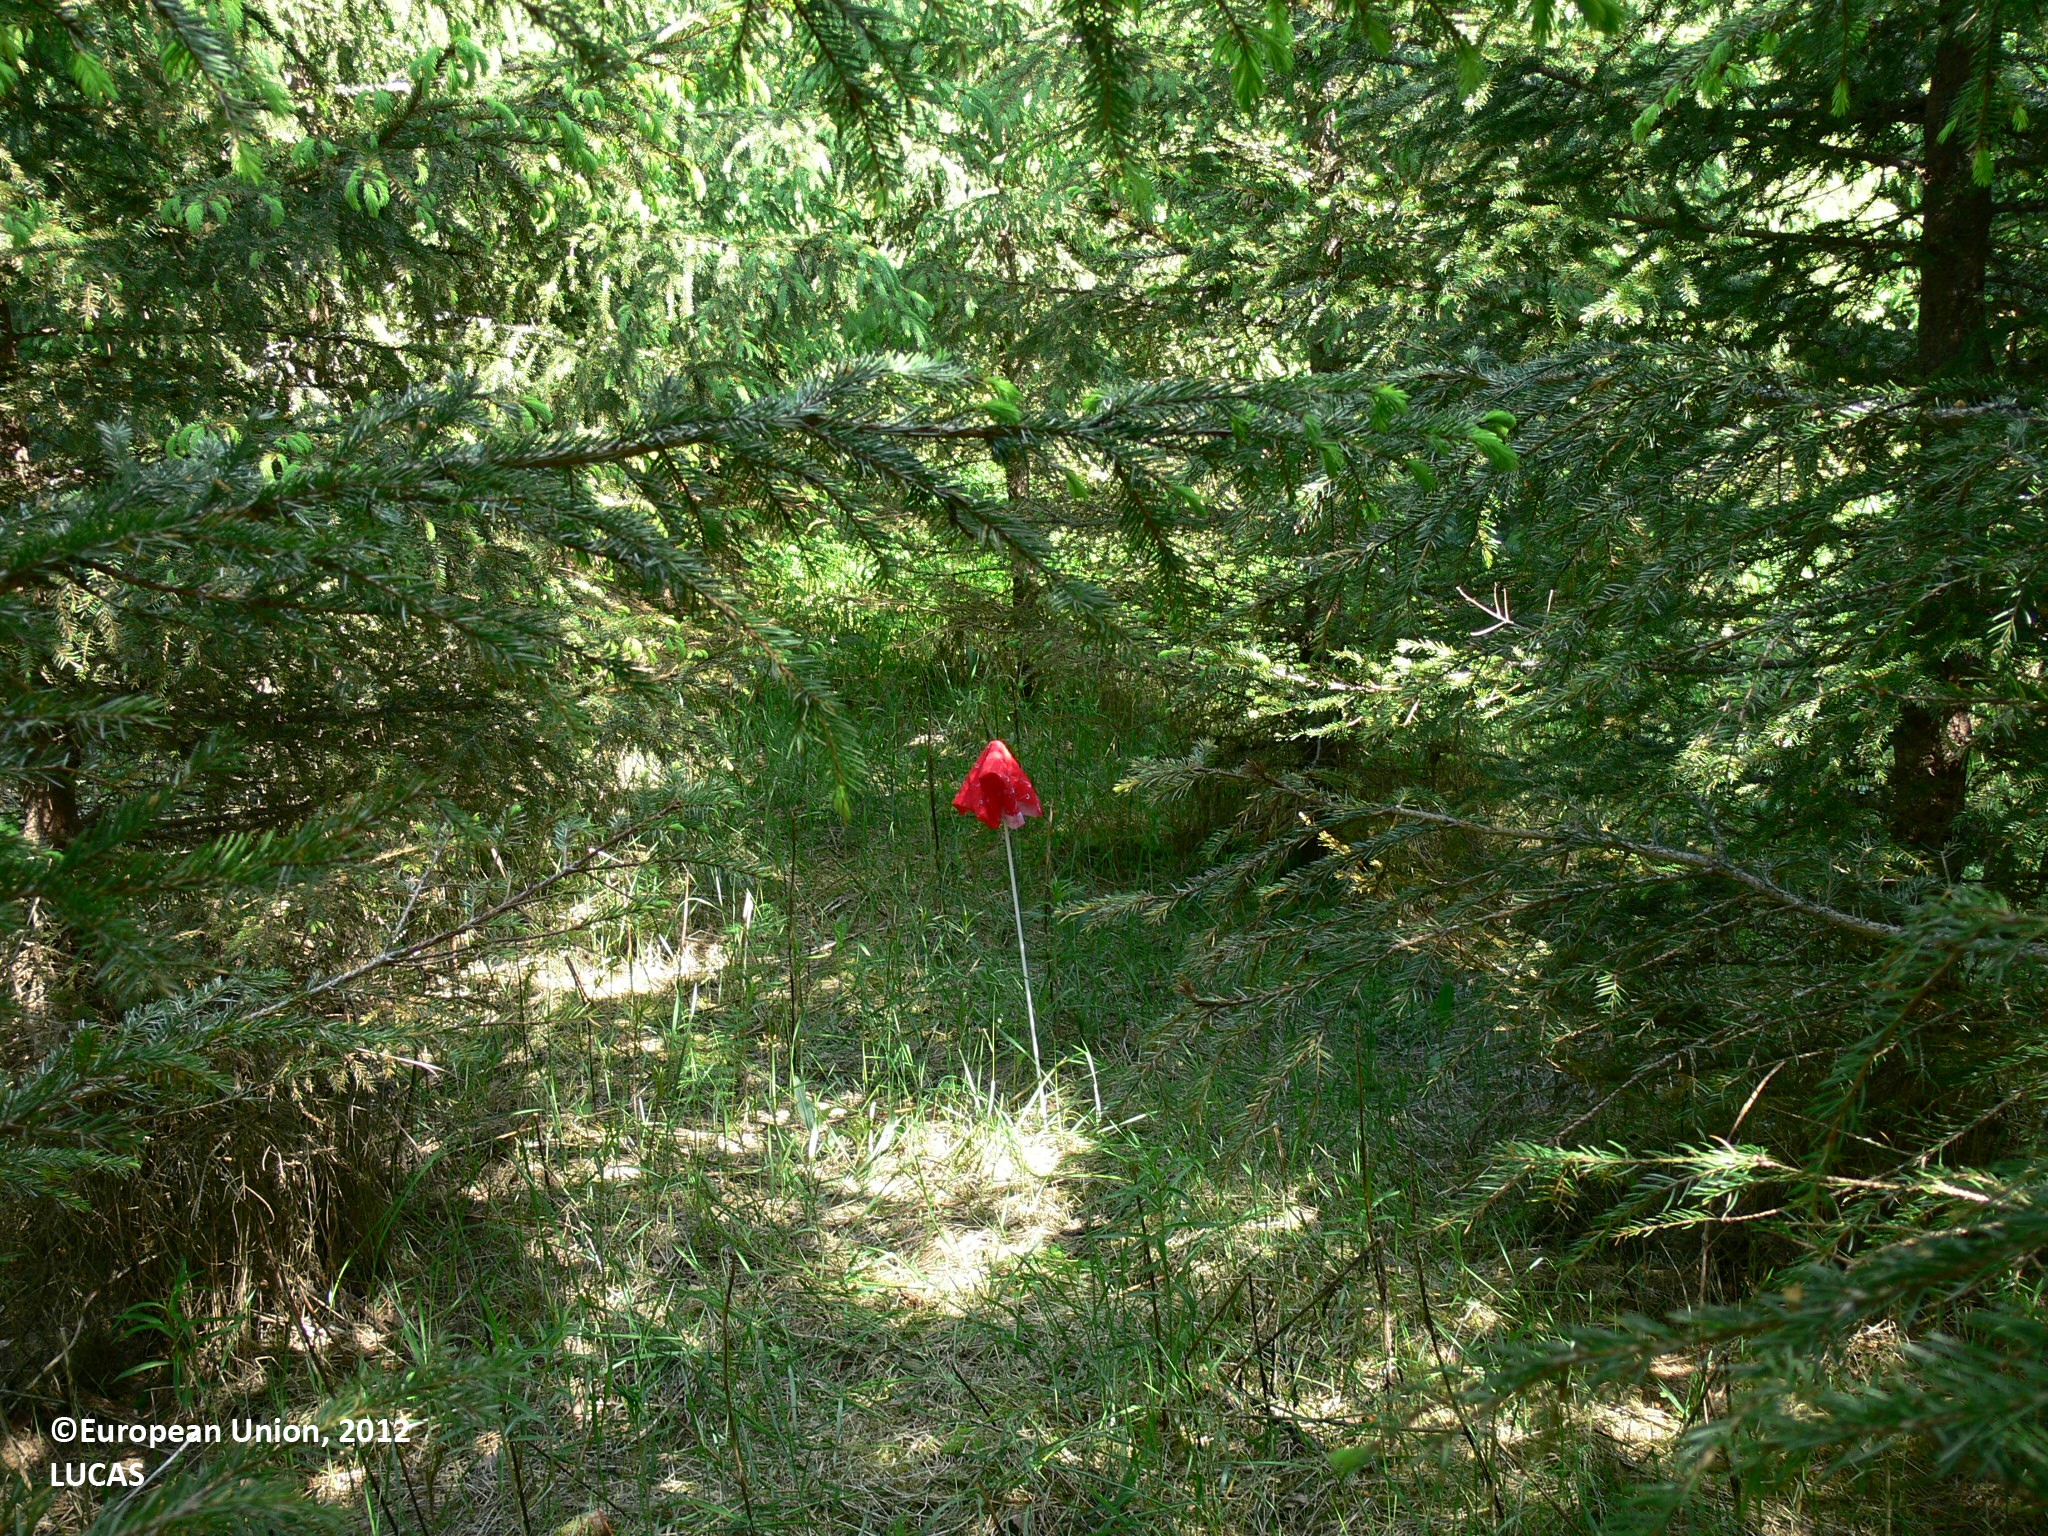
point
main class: Woodland
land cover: Spruce dominated coniferous woodland
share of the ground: > 75 %
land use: Forestry
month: June
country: FI
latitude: 62.3432
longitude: 30.4631
